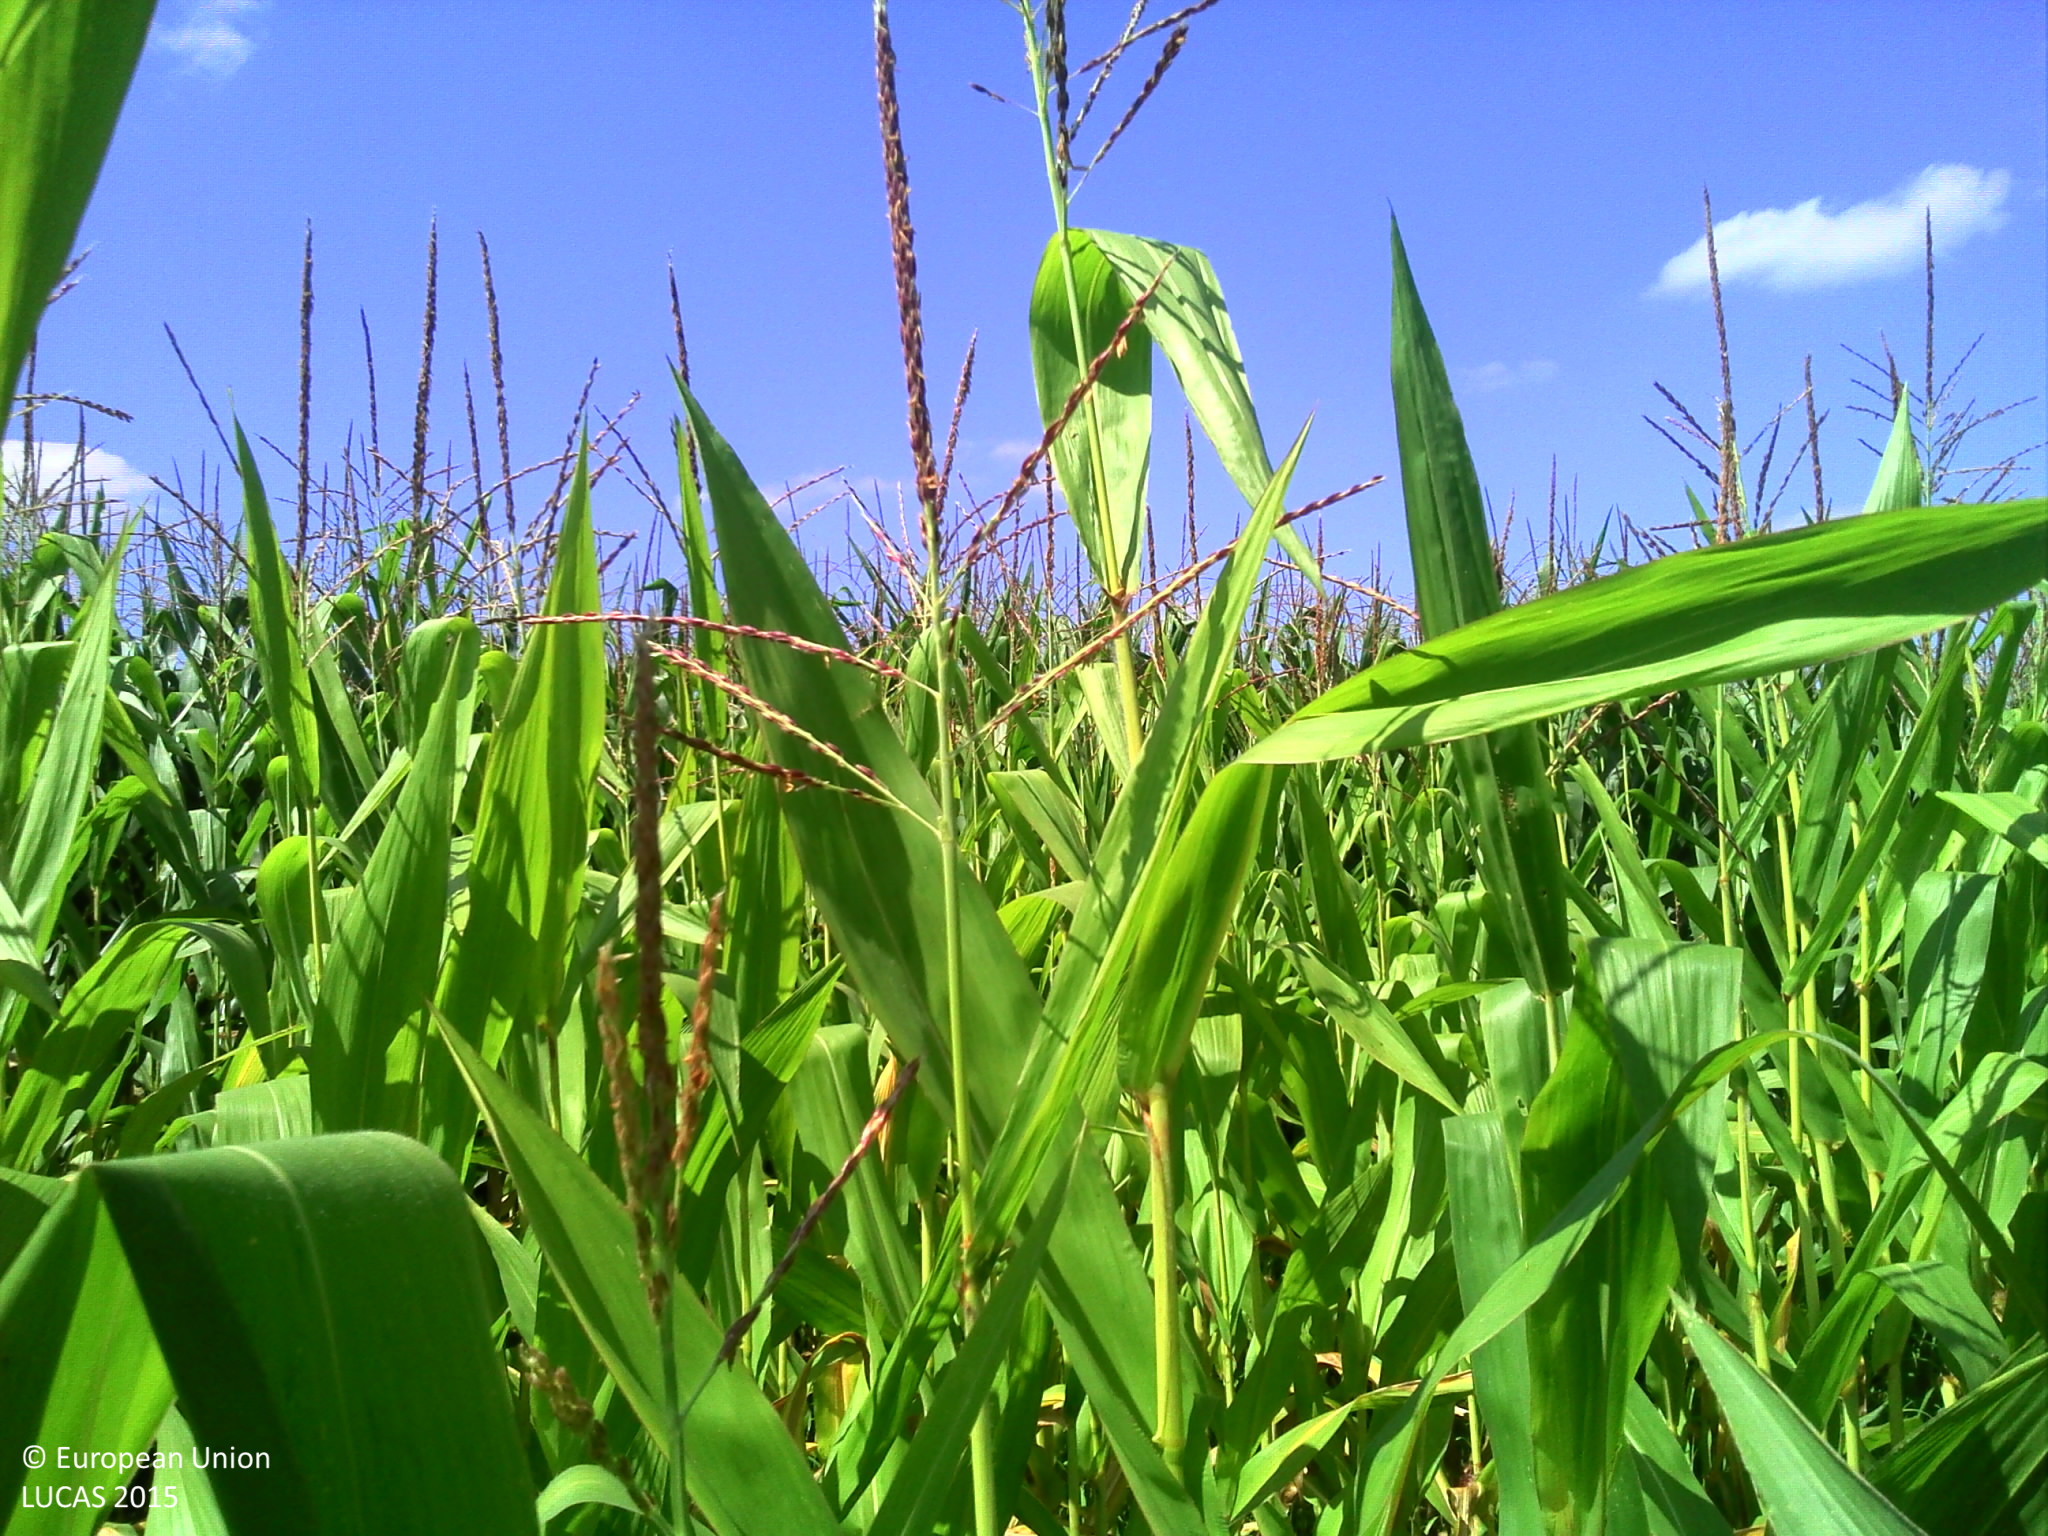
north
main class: Cropland
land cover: Maize
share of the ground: > 75 %
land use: Agriculture (excluding fallow land and kitchen gardens)
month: July
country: FR
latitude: 43.5662
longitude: -1.1461
